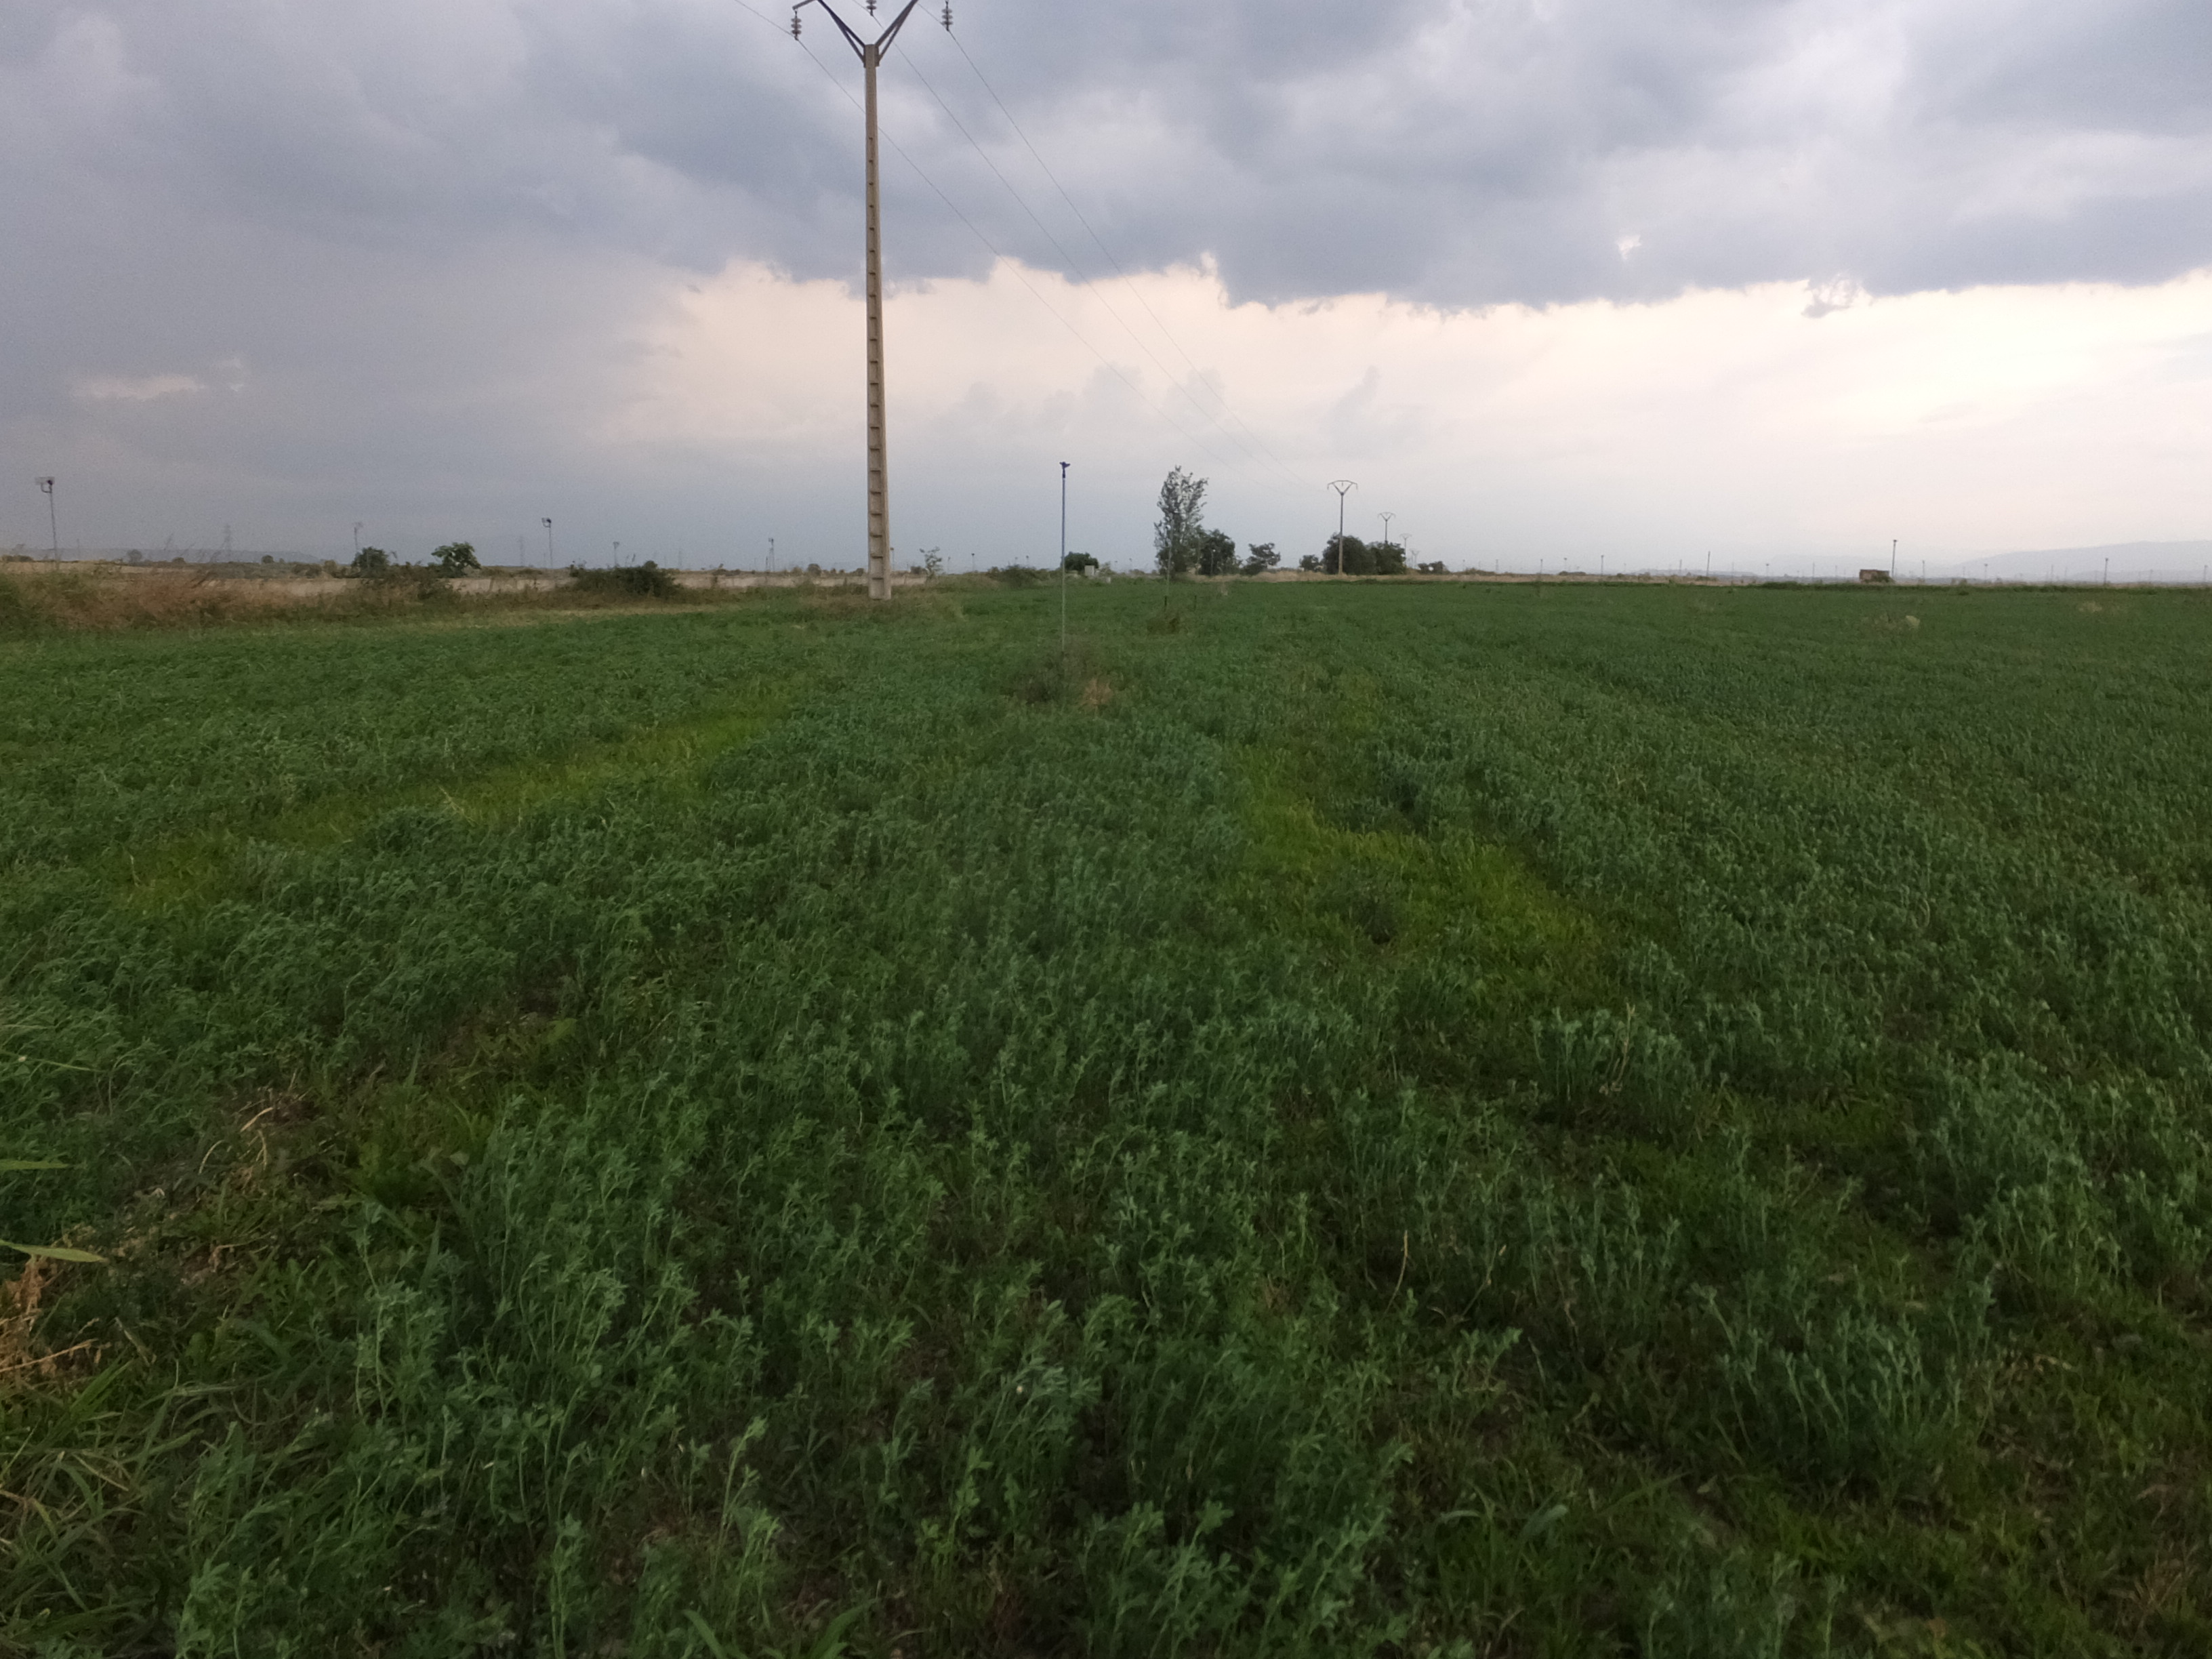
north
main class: Cropland
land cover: Lucerne
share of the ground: > 75 %
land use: Agriculture (excluding fallow land and kitchen gardens)
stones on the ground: < 10 %
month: June
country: ES
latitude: 41.8246
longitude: 0.1228
